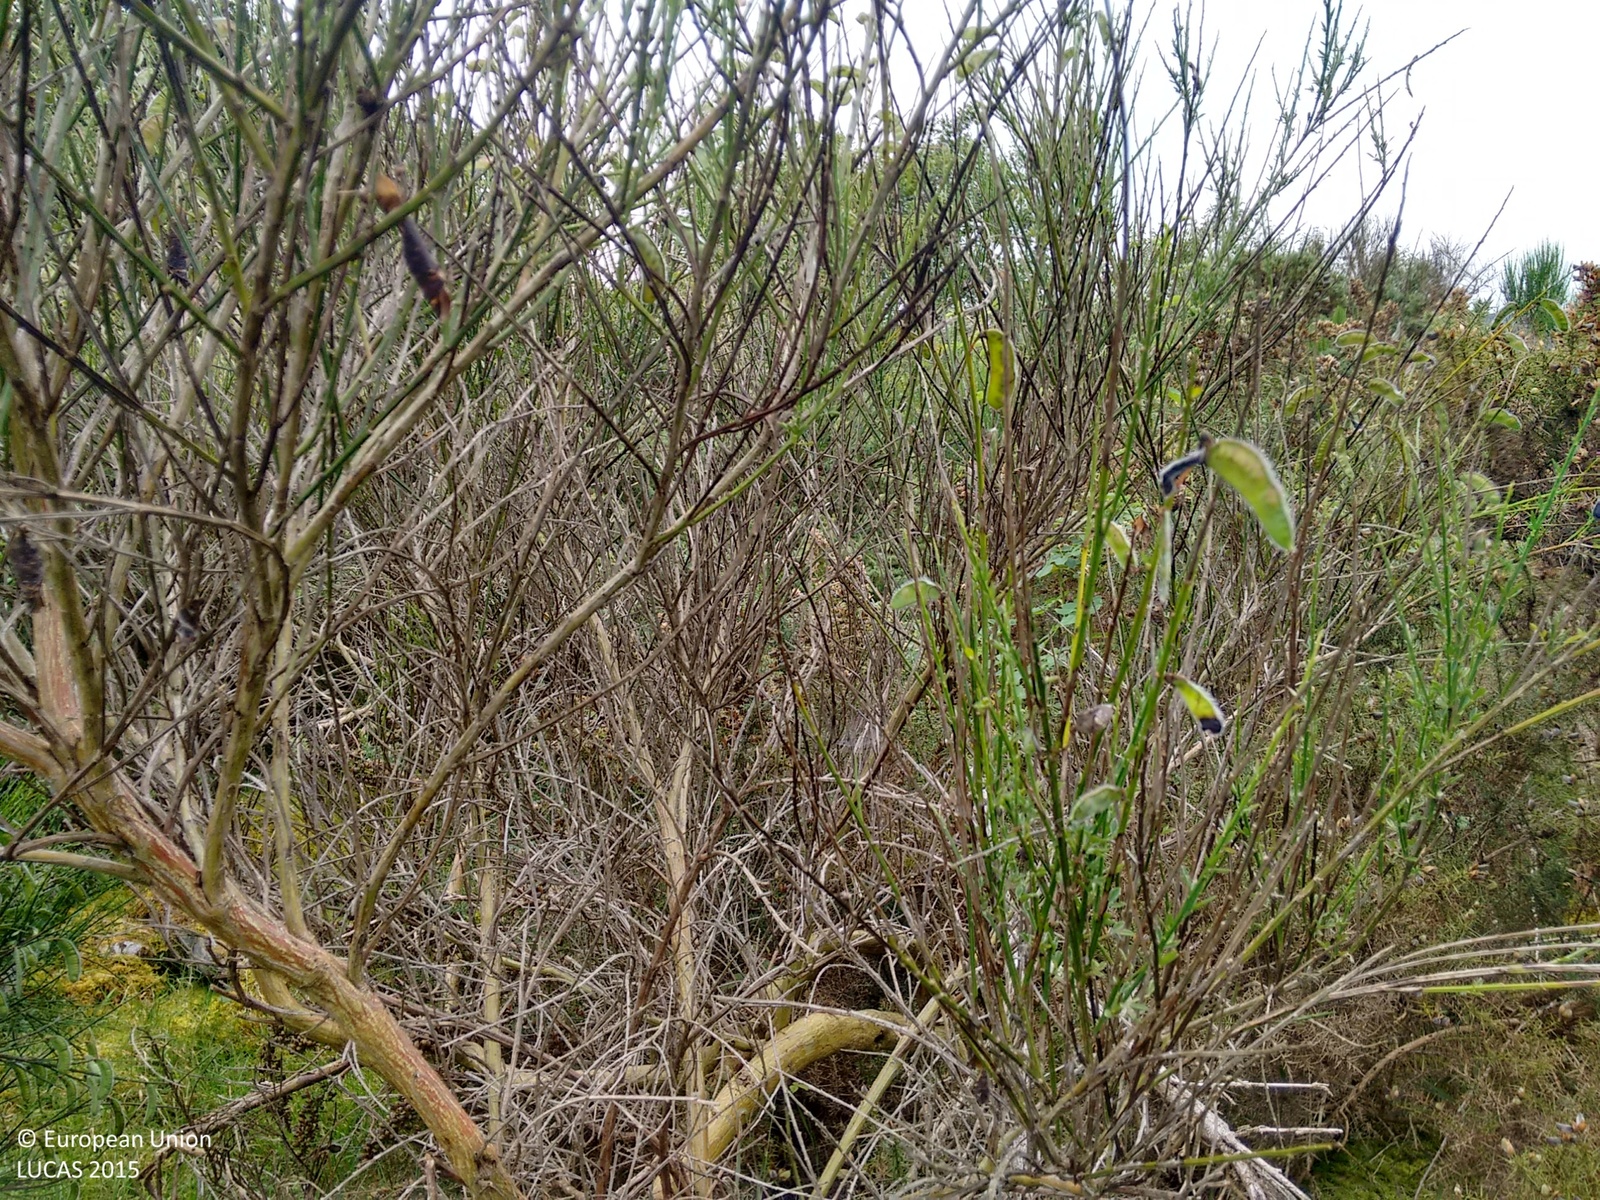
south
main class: Shrubland
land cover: Shrubland with sparse tree cover
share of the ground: > 75 %
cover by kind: shrubs 85 %, herbaceous plants 10 %, coniferous forest trees 5 %
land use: Agriculture (excluding fallow land and kitchen gardens)
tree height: > 5 m
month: August
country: GB
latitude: 57.5363
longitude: -4.5064
